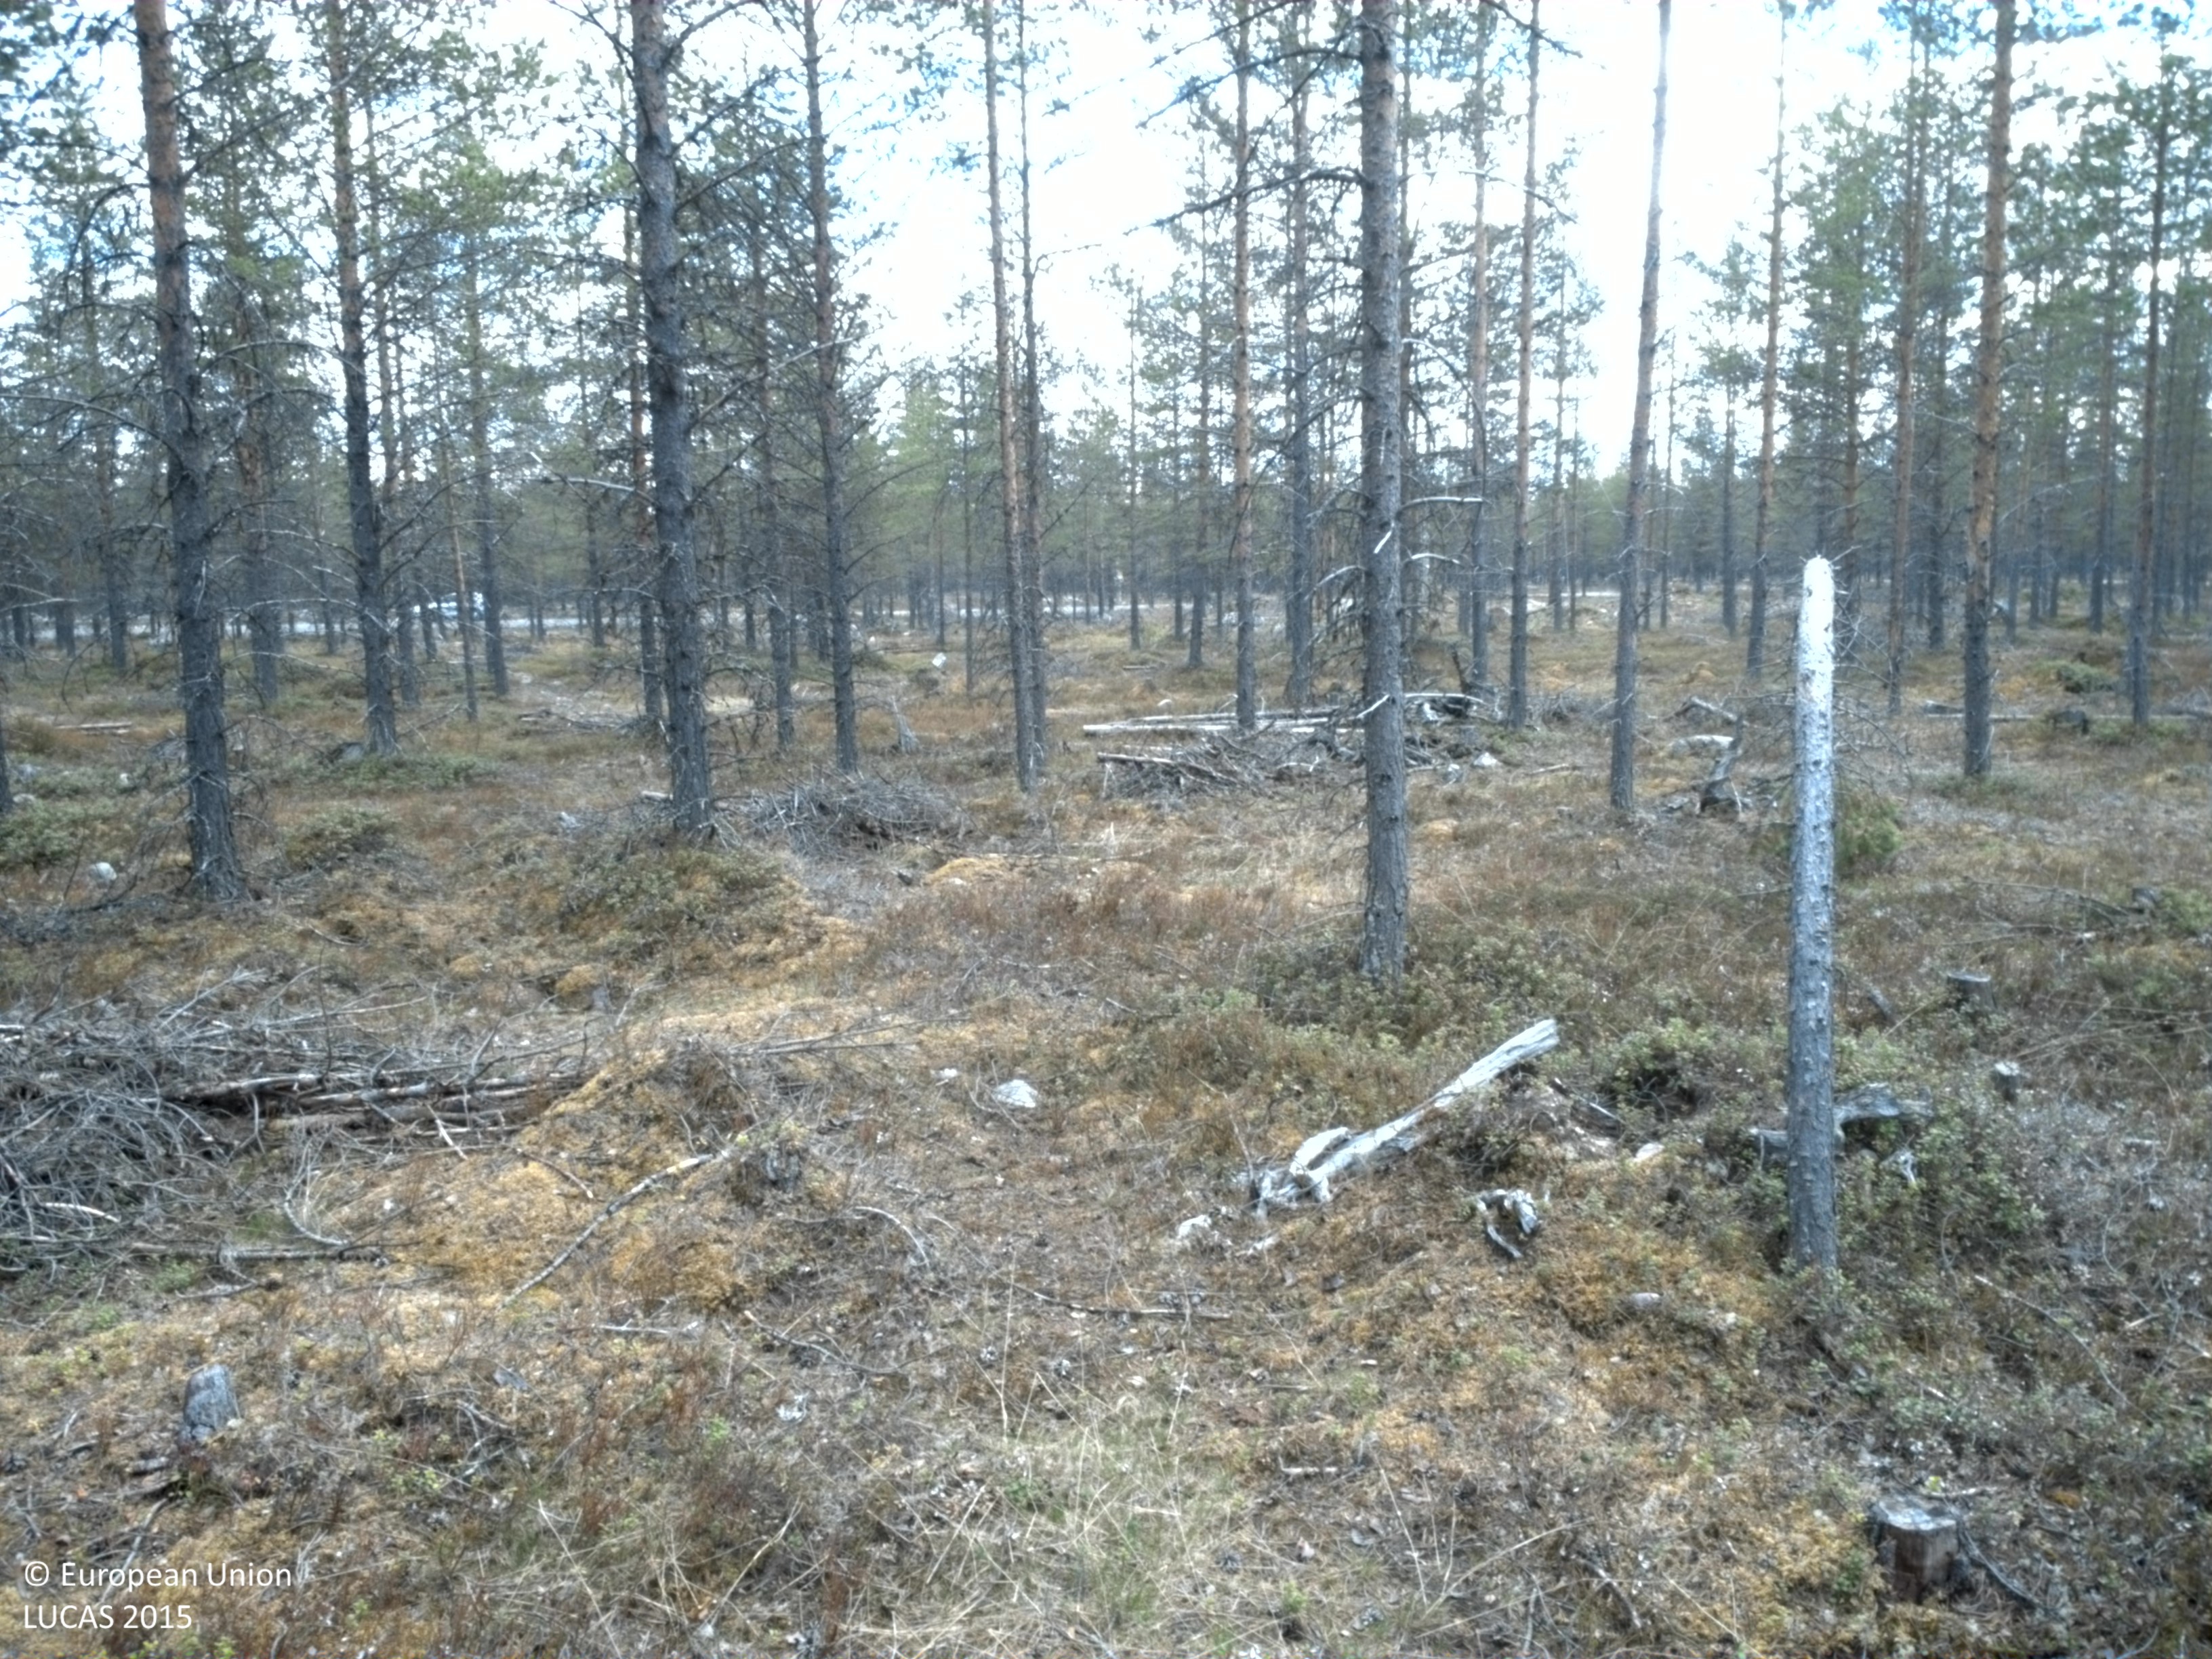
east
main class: Woodland
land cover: Pine dominated coniferous woodland
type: boreal forest
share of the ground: 25 - 50 %
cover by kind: shrubs 55 %, coniferous forest trees 40 %, lichens and mosses 5 %
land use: Forestry
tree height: > 5 m
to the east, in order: Pine dominated coniferous woodland; Shrubland with sparse tree cover; Electric lines; Shrubland with sparse tree cover; Pine dominated coniferous woodland; Rocks and stones; Paved roads, cycling and walking lanes; Shrubland with sparse tree cover; Pine dominated coniferous woodland
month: June
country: SE
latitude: 66.2391
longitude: 18.6056
